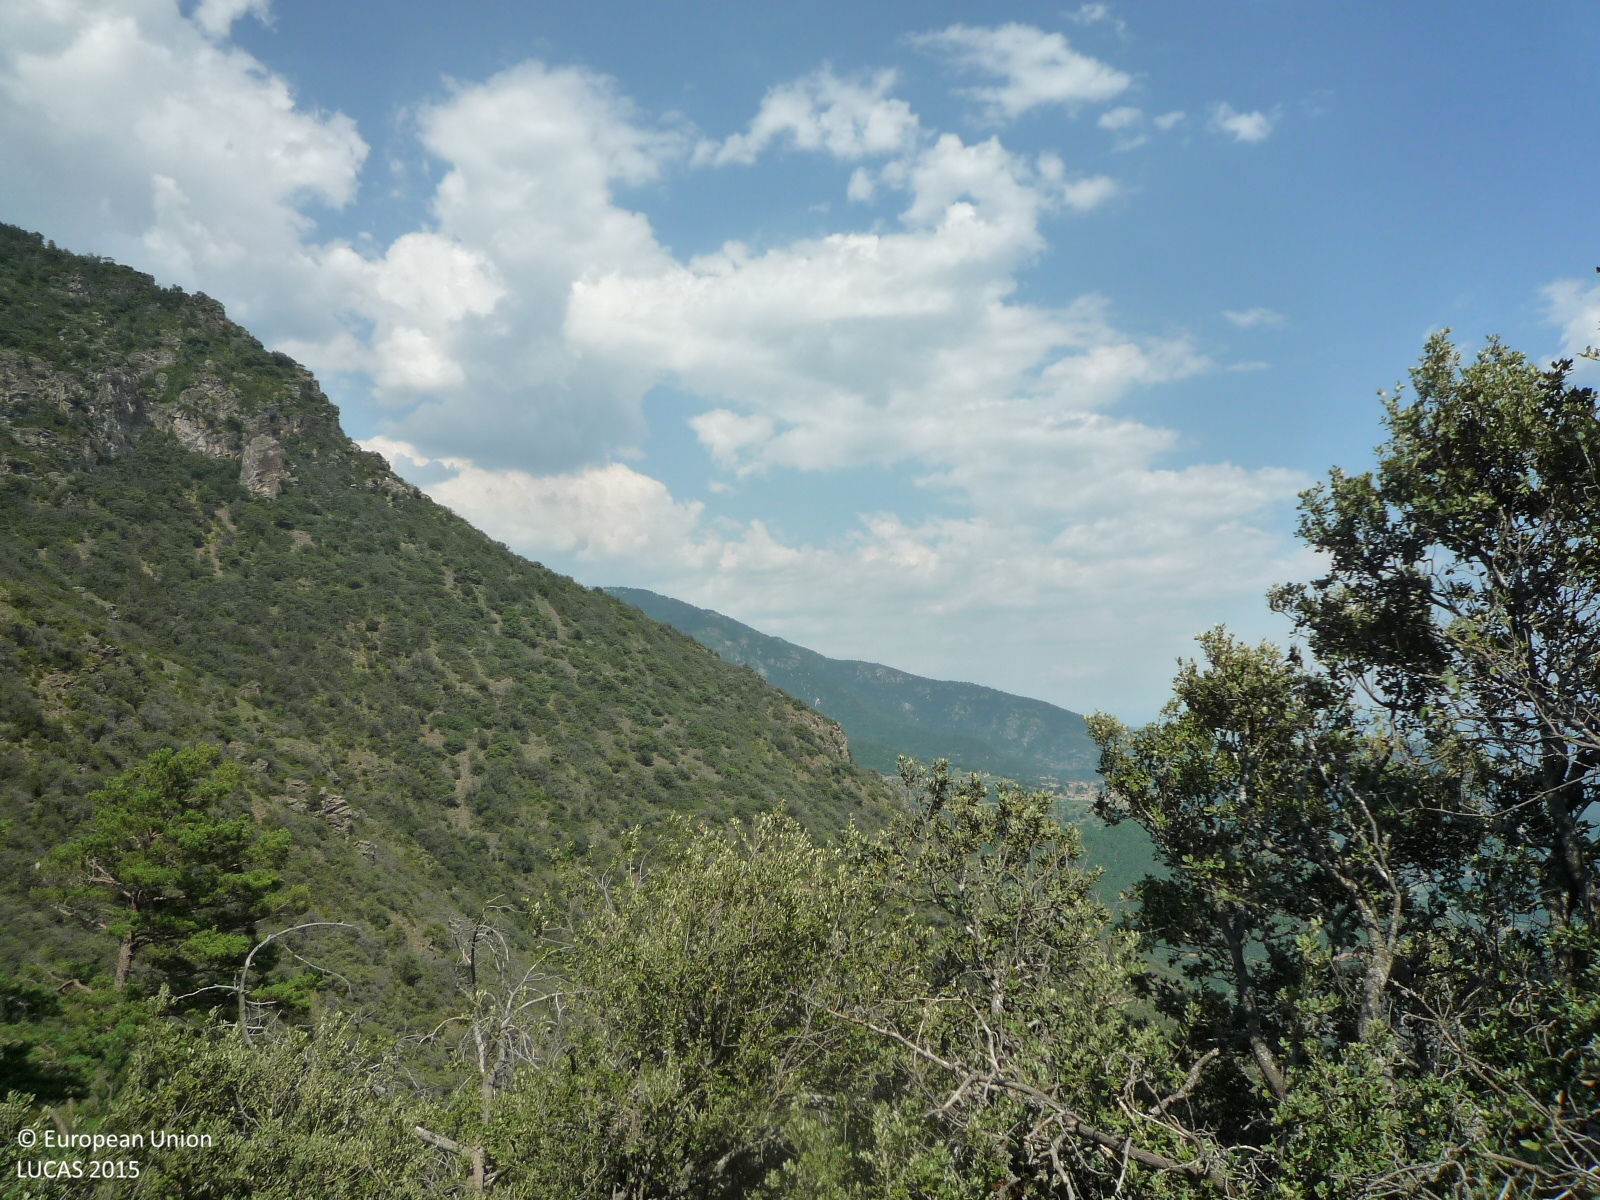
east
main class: Woodland
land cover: Pine dominated mixed woodland
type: alpine coniferous forest
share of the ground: > 75 %
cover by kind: broadleaved forest trees 40 %, coniferous forest trees 30 %, shrubs 20 %, consolidated bare surface 10 %
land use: Semi-natural and natural areas not in use
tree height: < 5 m
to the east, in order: Pine dominated mixed woodland; Shrubland with sparse tree cover; Rivers and streams; Pine dominated mixed woodland
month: June
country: ES
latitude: 42.3767
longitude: 1.5941
